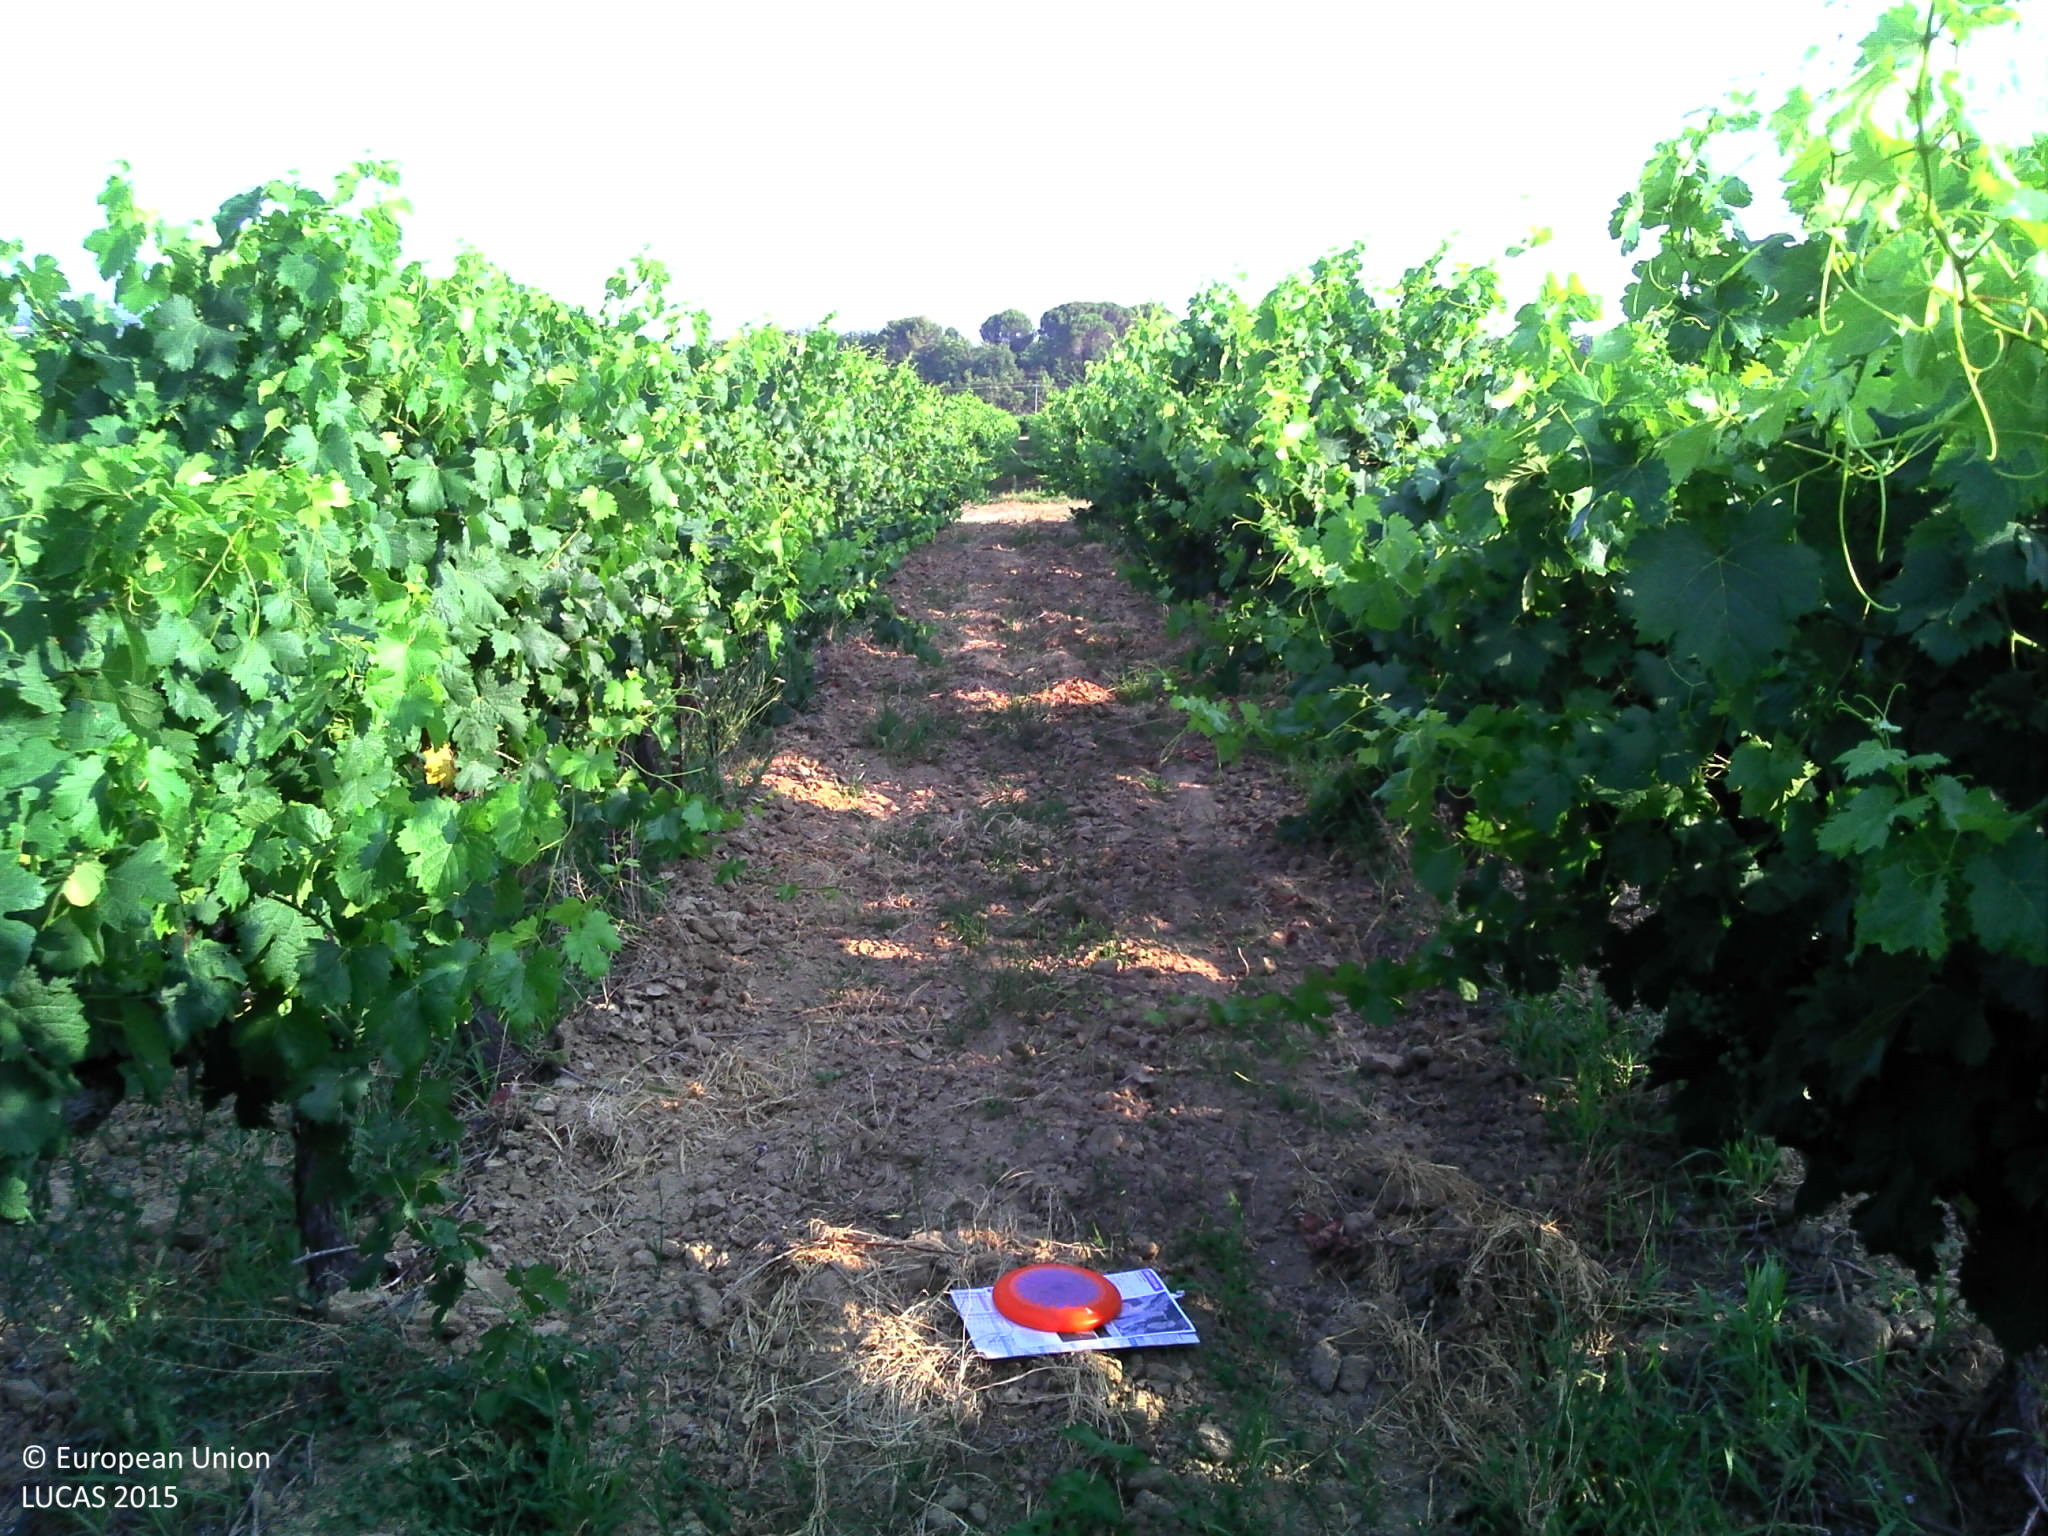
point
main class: Cropland
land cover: Vineyards
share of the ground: 25 - 50 %
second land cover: Other bare soil
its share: > 75 %
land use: Agriculture (excluding fallow land and kitchen gardens)
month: July
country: FR
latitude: 43.7493
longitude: 5.5506
